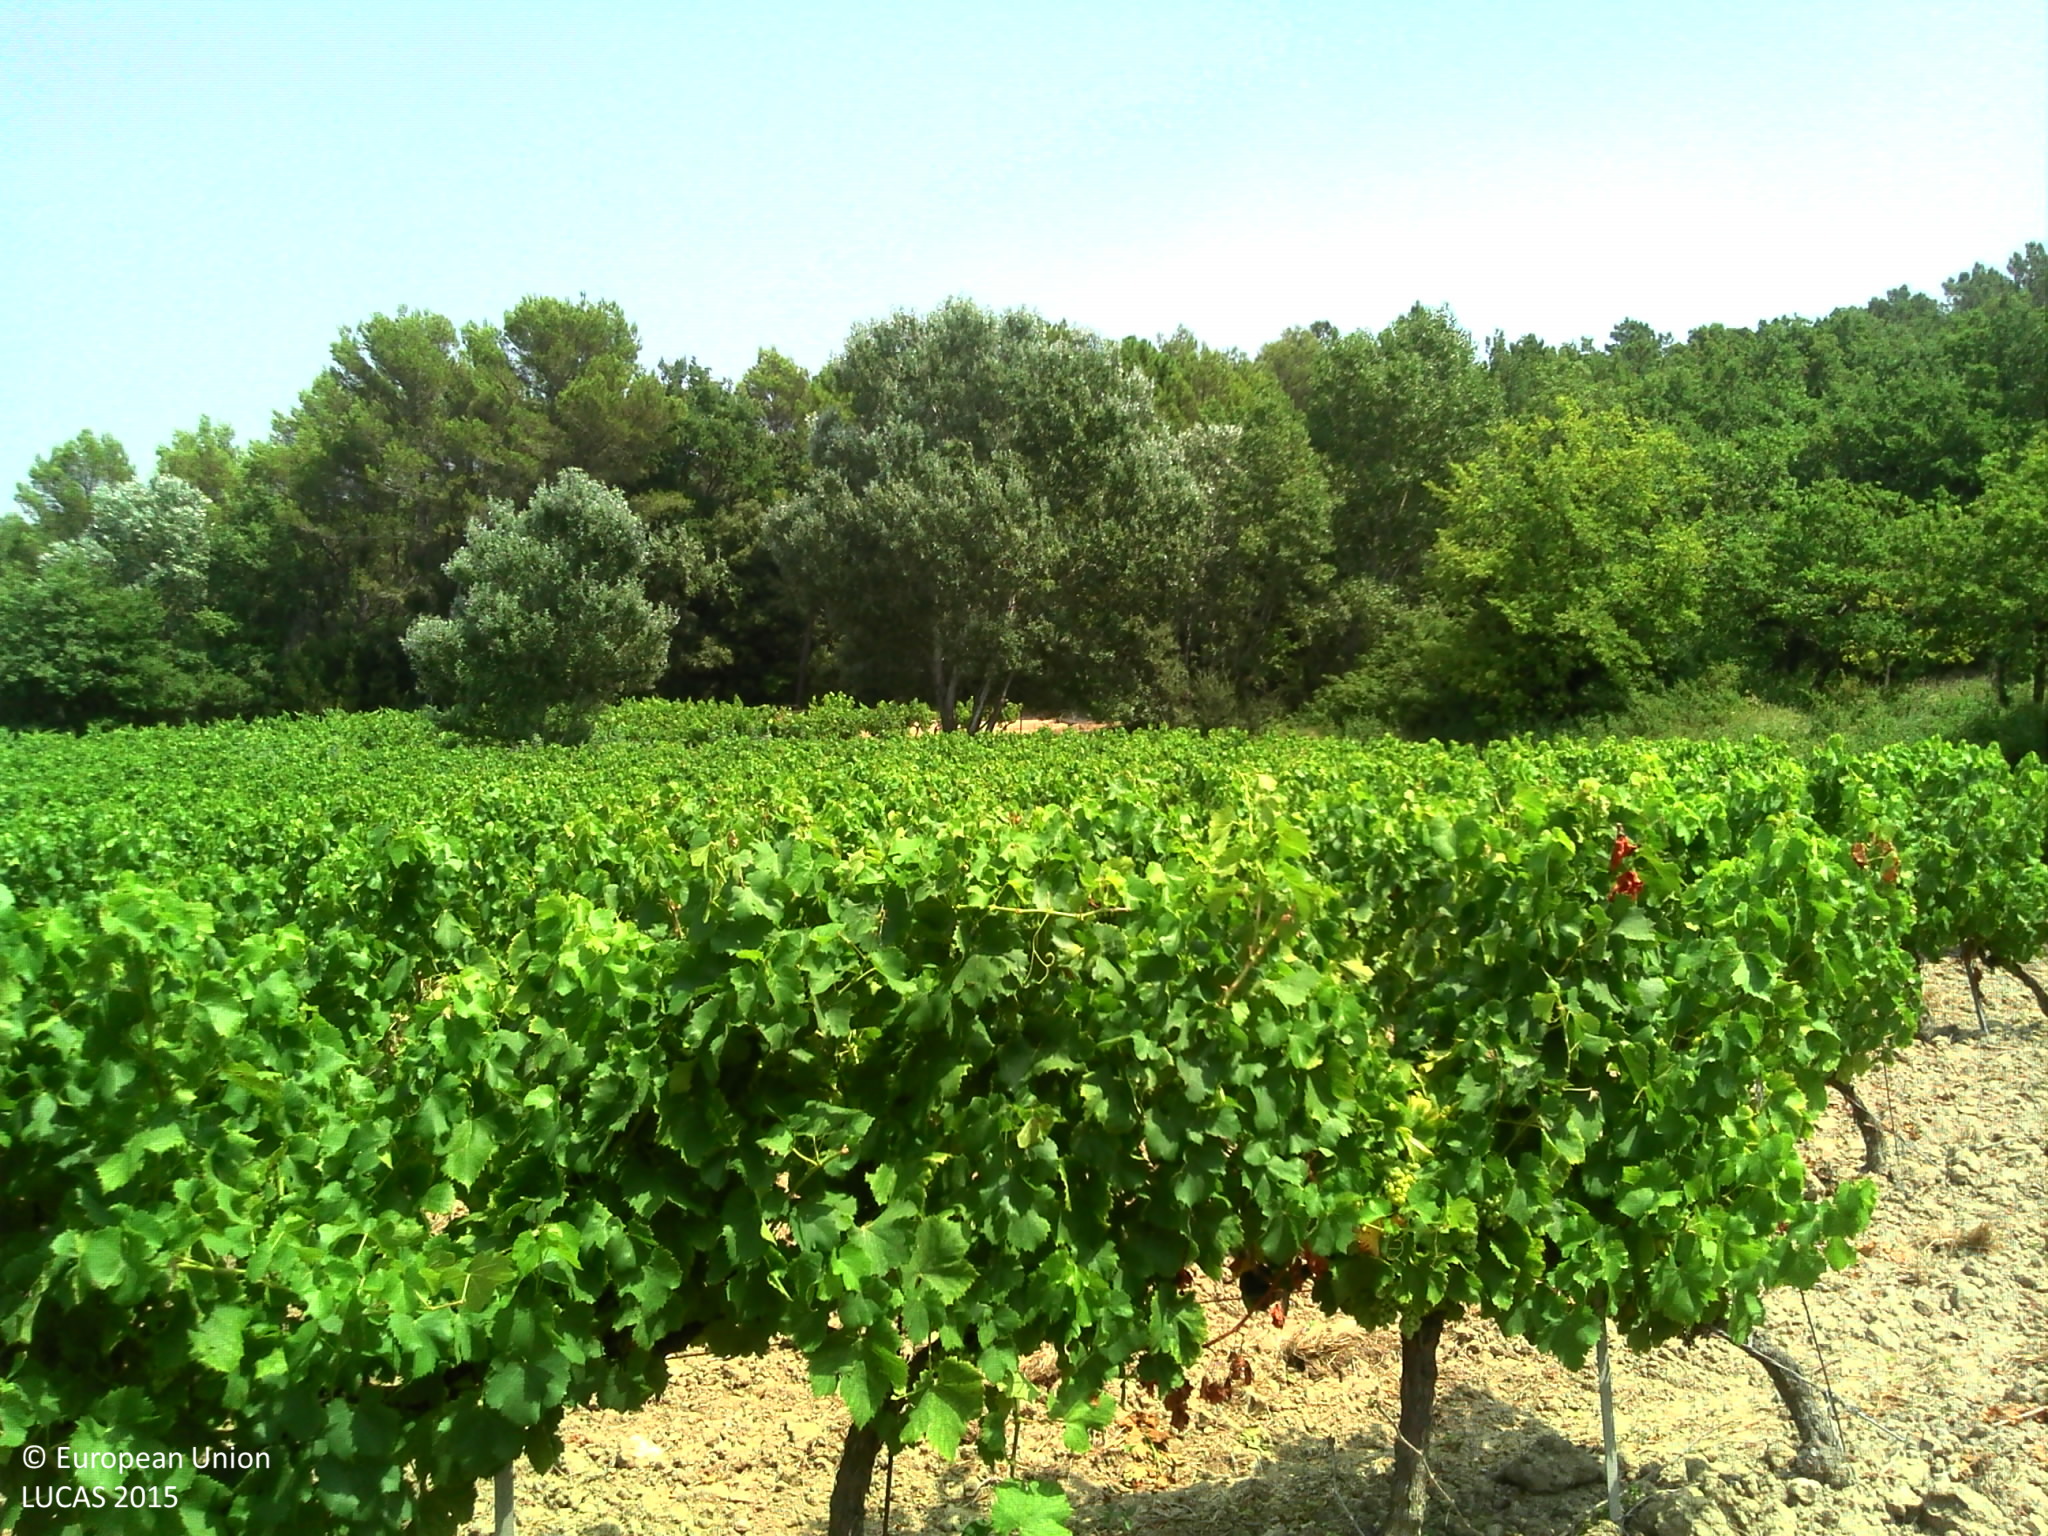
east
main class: Cropland
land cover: Vineyards
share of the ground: 50 - 75 %
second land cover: Other bare soil
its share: > 75 %
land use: Agriculture (excluding fallow land and kitchen gardens)
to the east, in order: Vineyards; Other bare soil; Grass margins; Ditches and canals; Single bushes/trees; Grass margins; Vineyards; Pine dominated mixed woodland
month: July
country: FR
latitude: 44.2351
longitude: 4.7366
